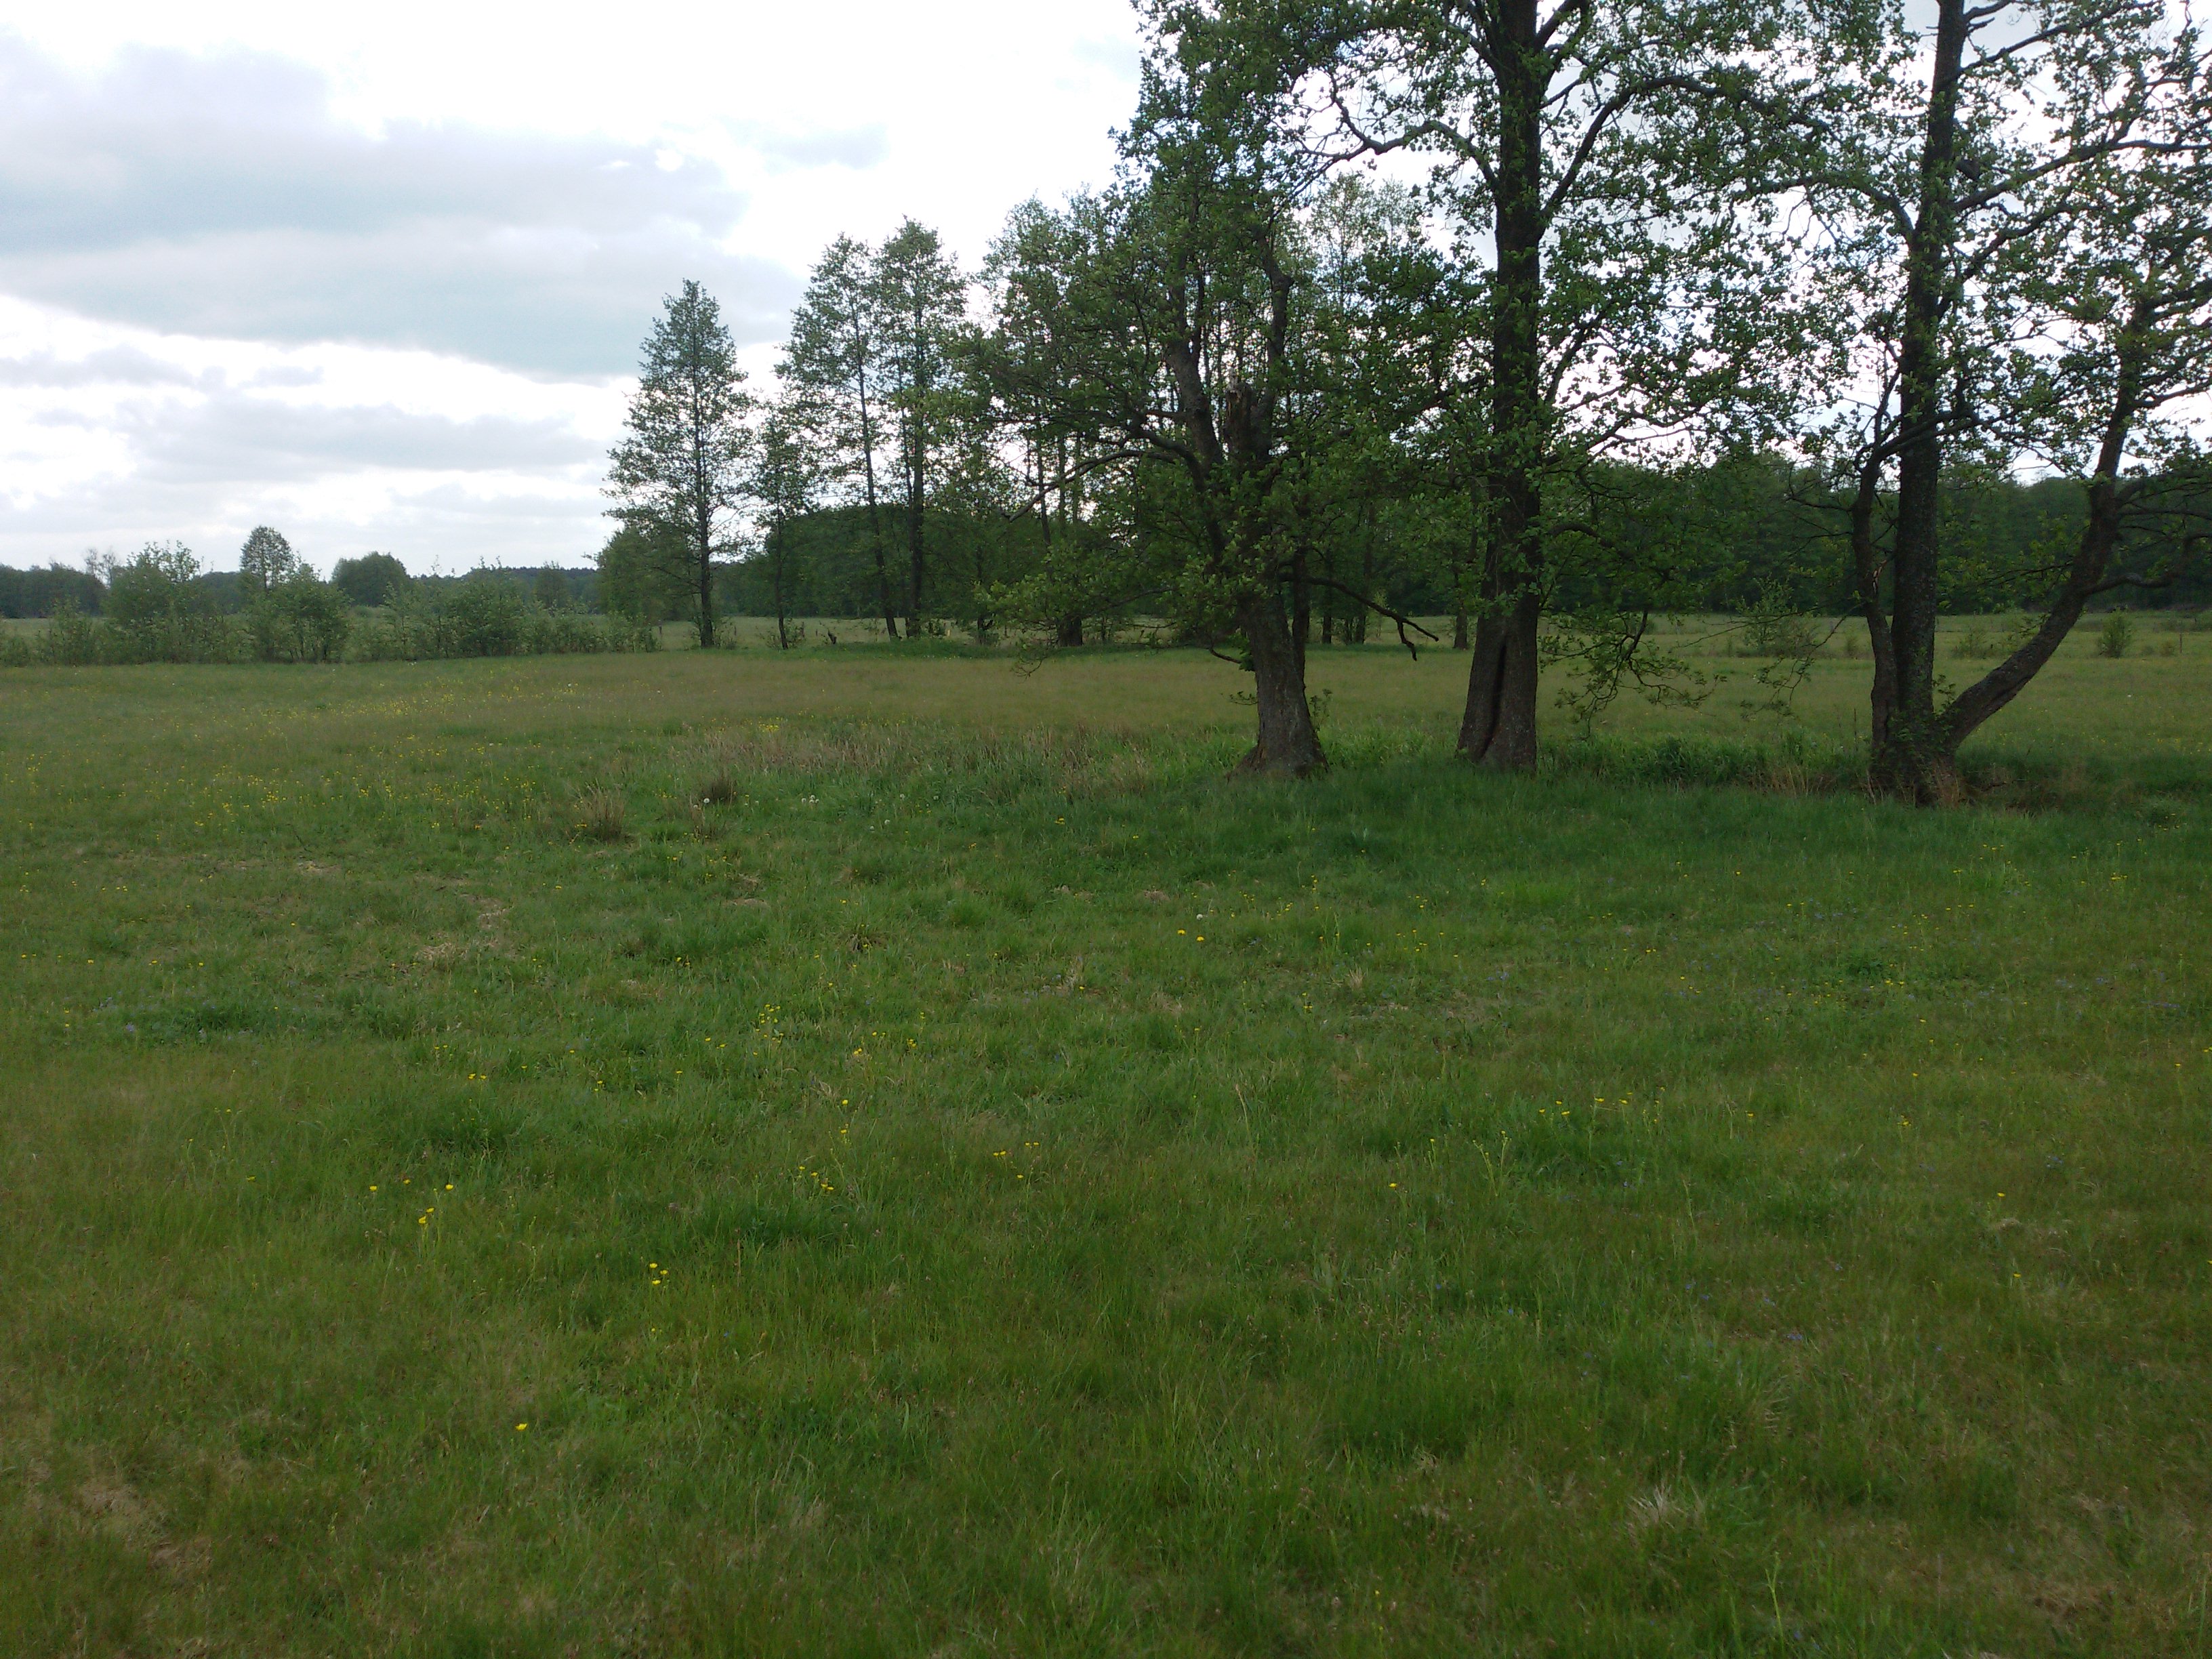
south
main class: Grassland
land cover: Grassland without tree/shrub cover
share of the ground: > 75 %
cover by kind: herbaceous plants 100 %
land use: Agriculture (excluding fallow land and kitchen gardens)
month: May
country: PL
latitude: 53.5129
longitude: 21.0372
